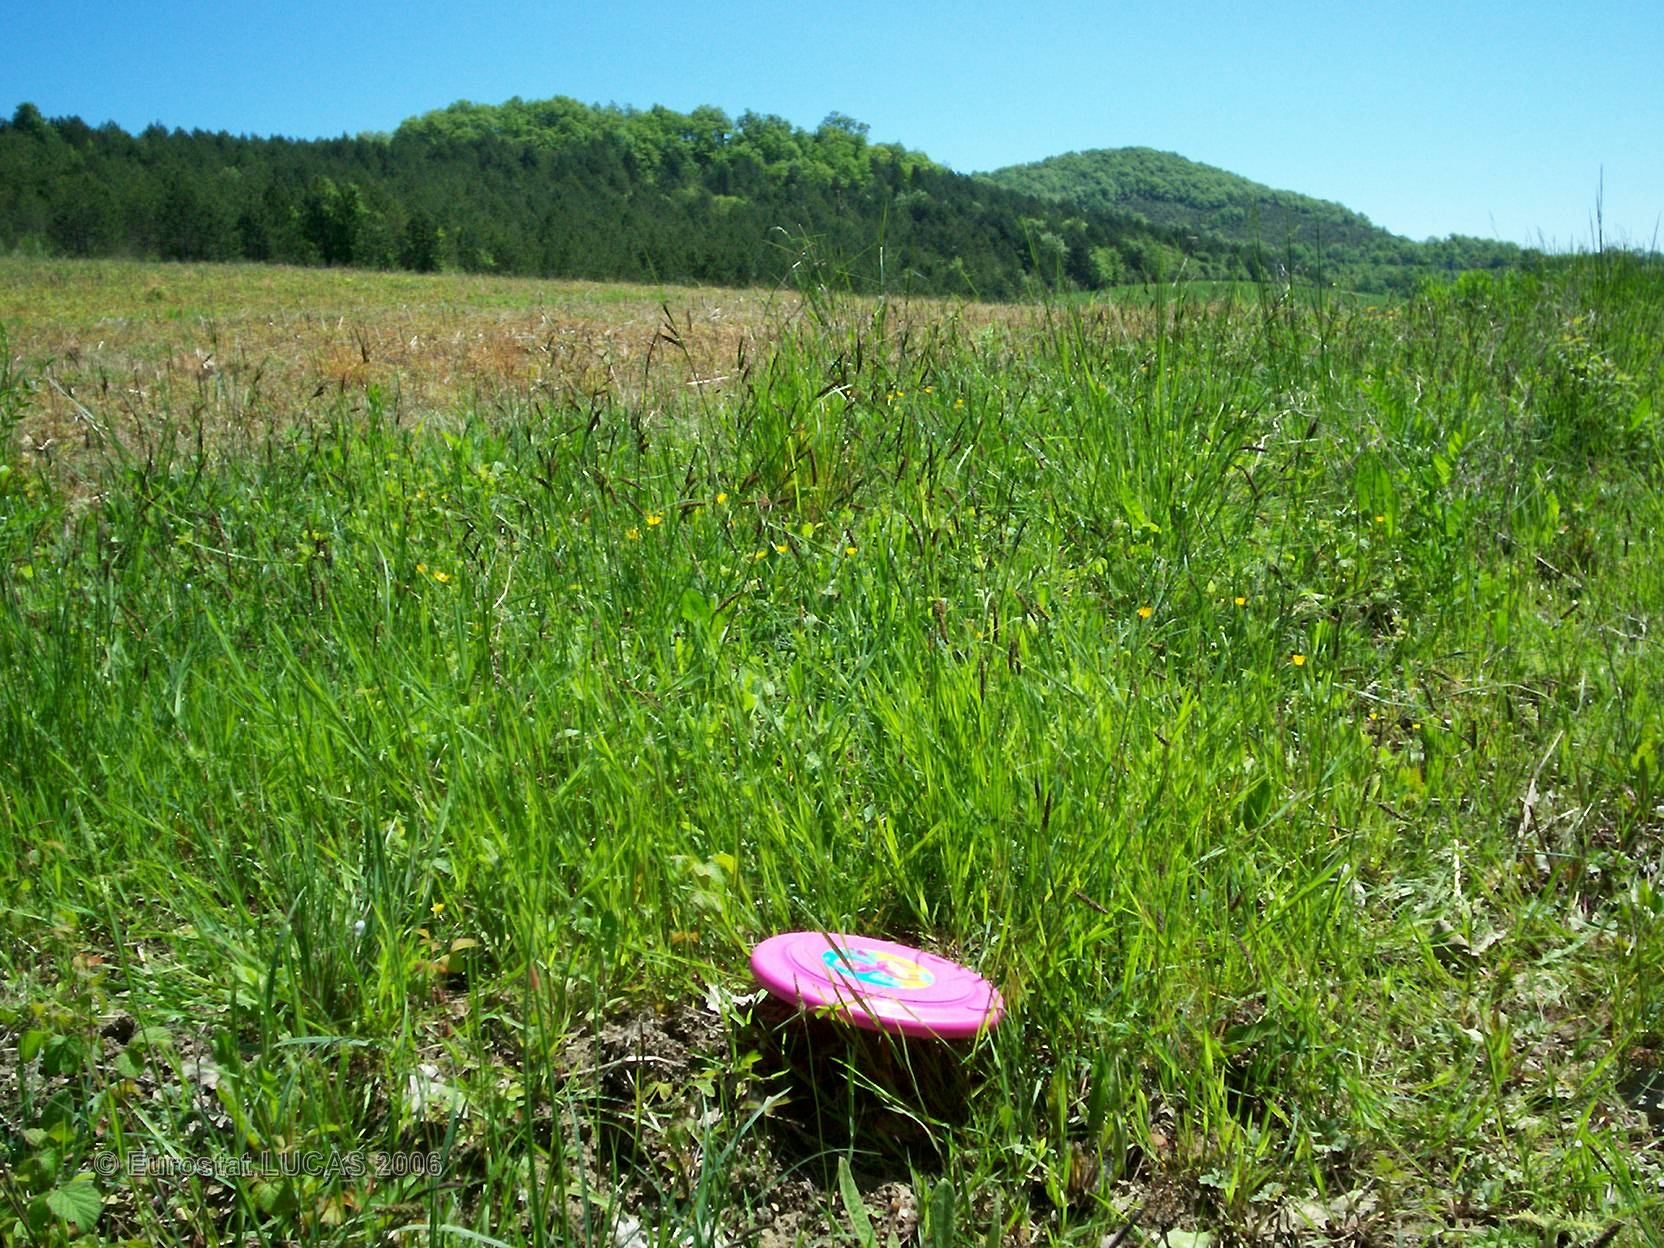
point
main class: Grassland
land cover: Grassland without tree/shrub cover
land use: Agriculture (excluding fallow land and kitchen gardens)
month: May
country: FR
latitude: 43.1529
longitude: 0.9149
